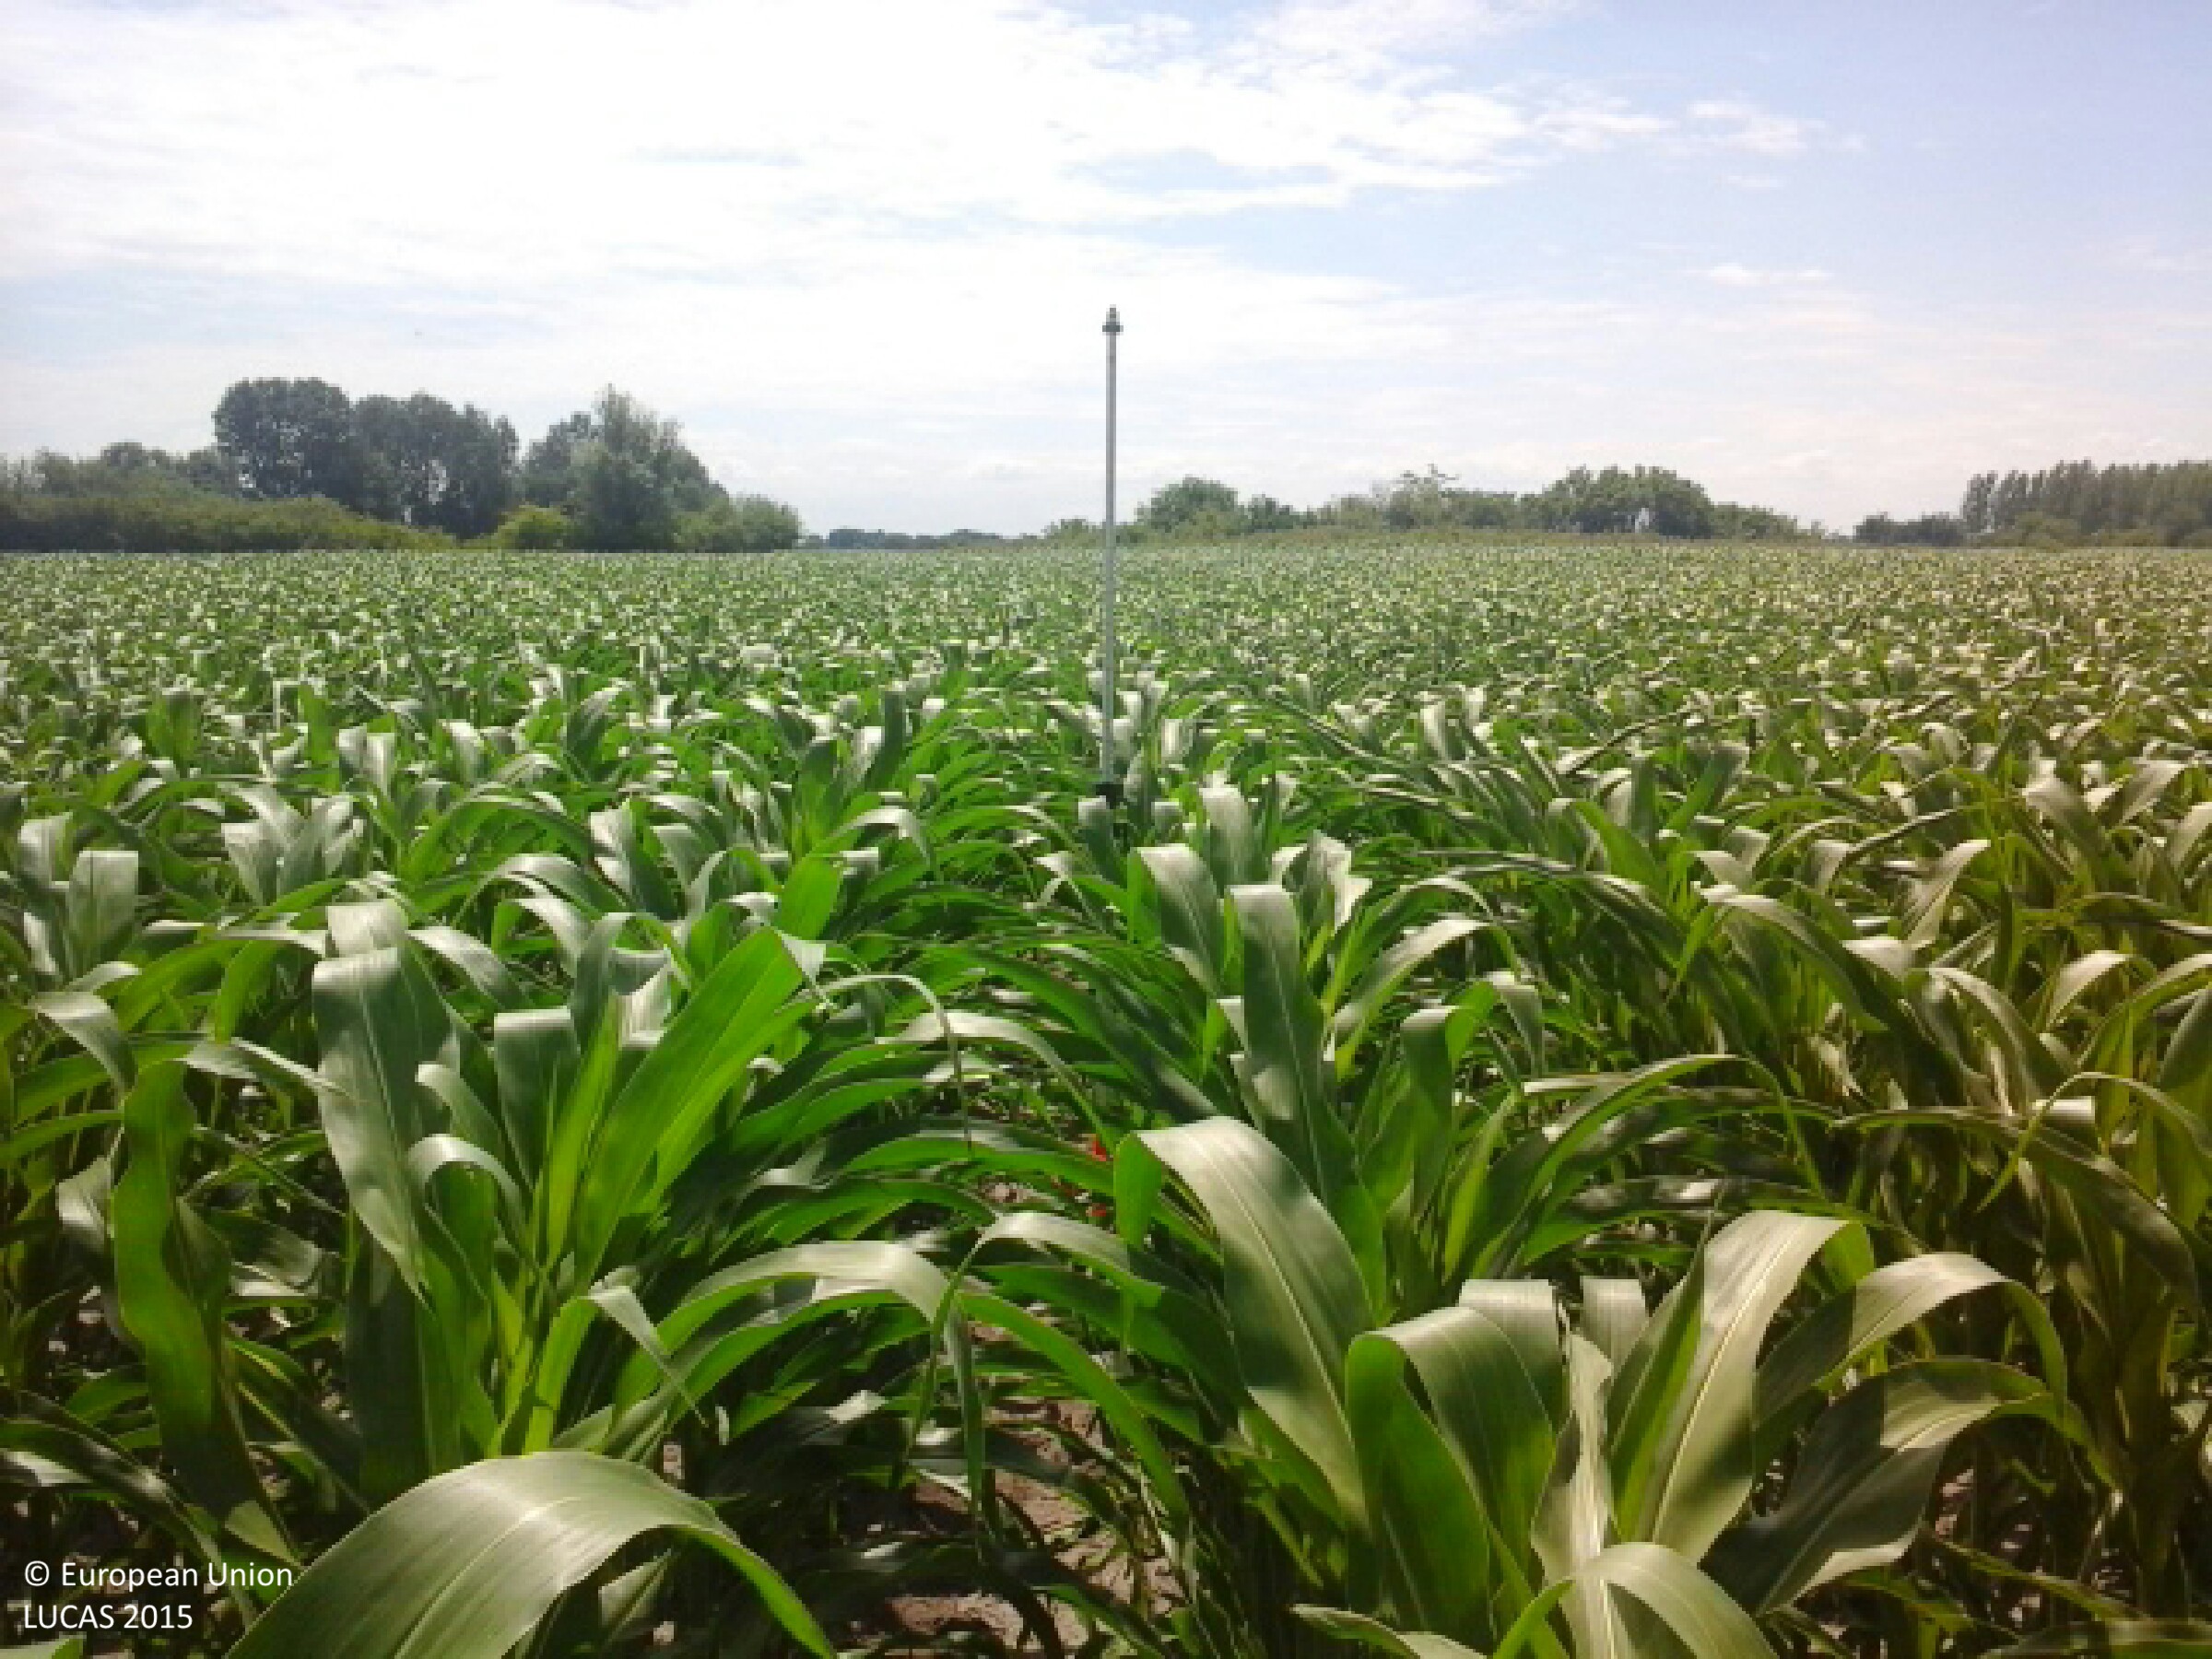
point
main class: Cropland
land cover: Maize
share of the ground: > 75 %
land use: Agriculture (excluding fallow land and kitchen gardens)
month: June
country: HU
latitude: 48.0083
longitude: 21.9412
